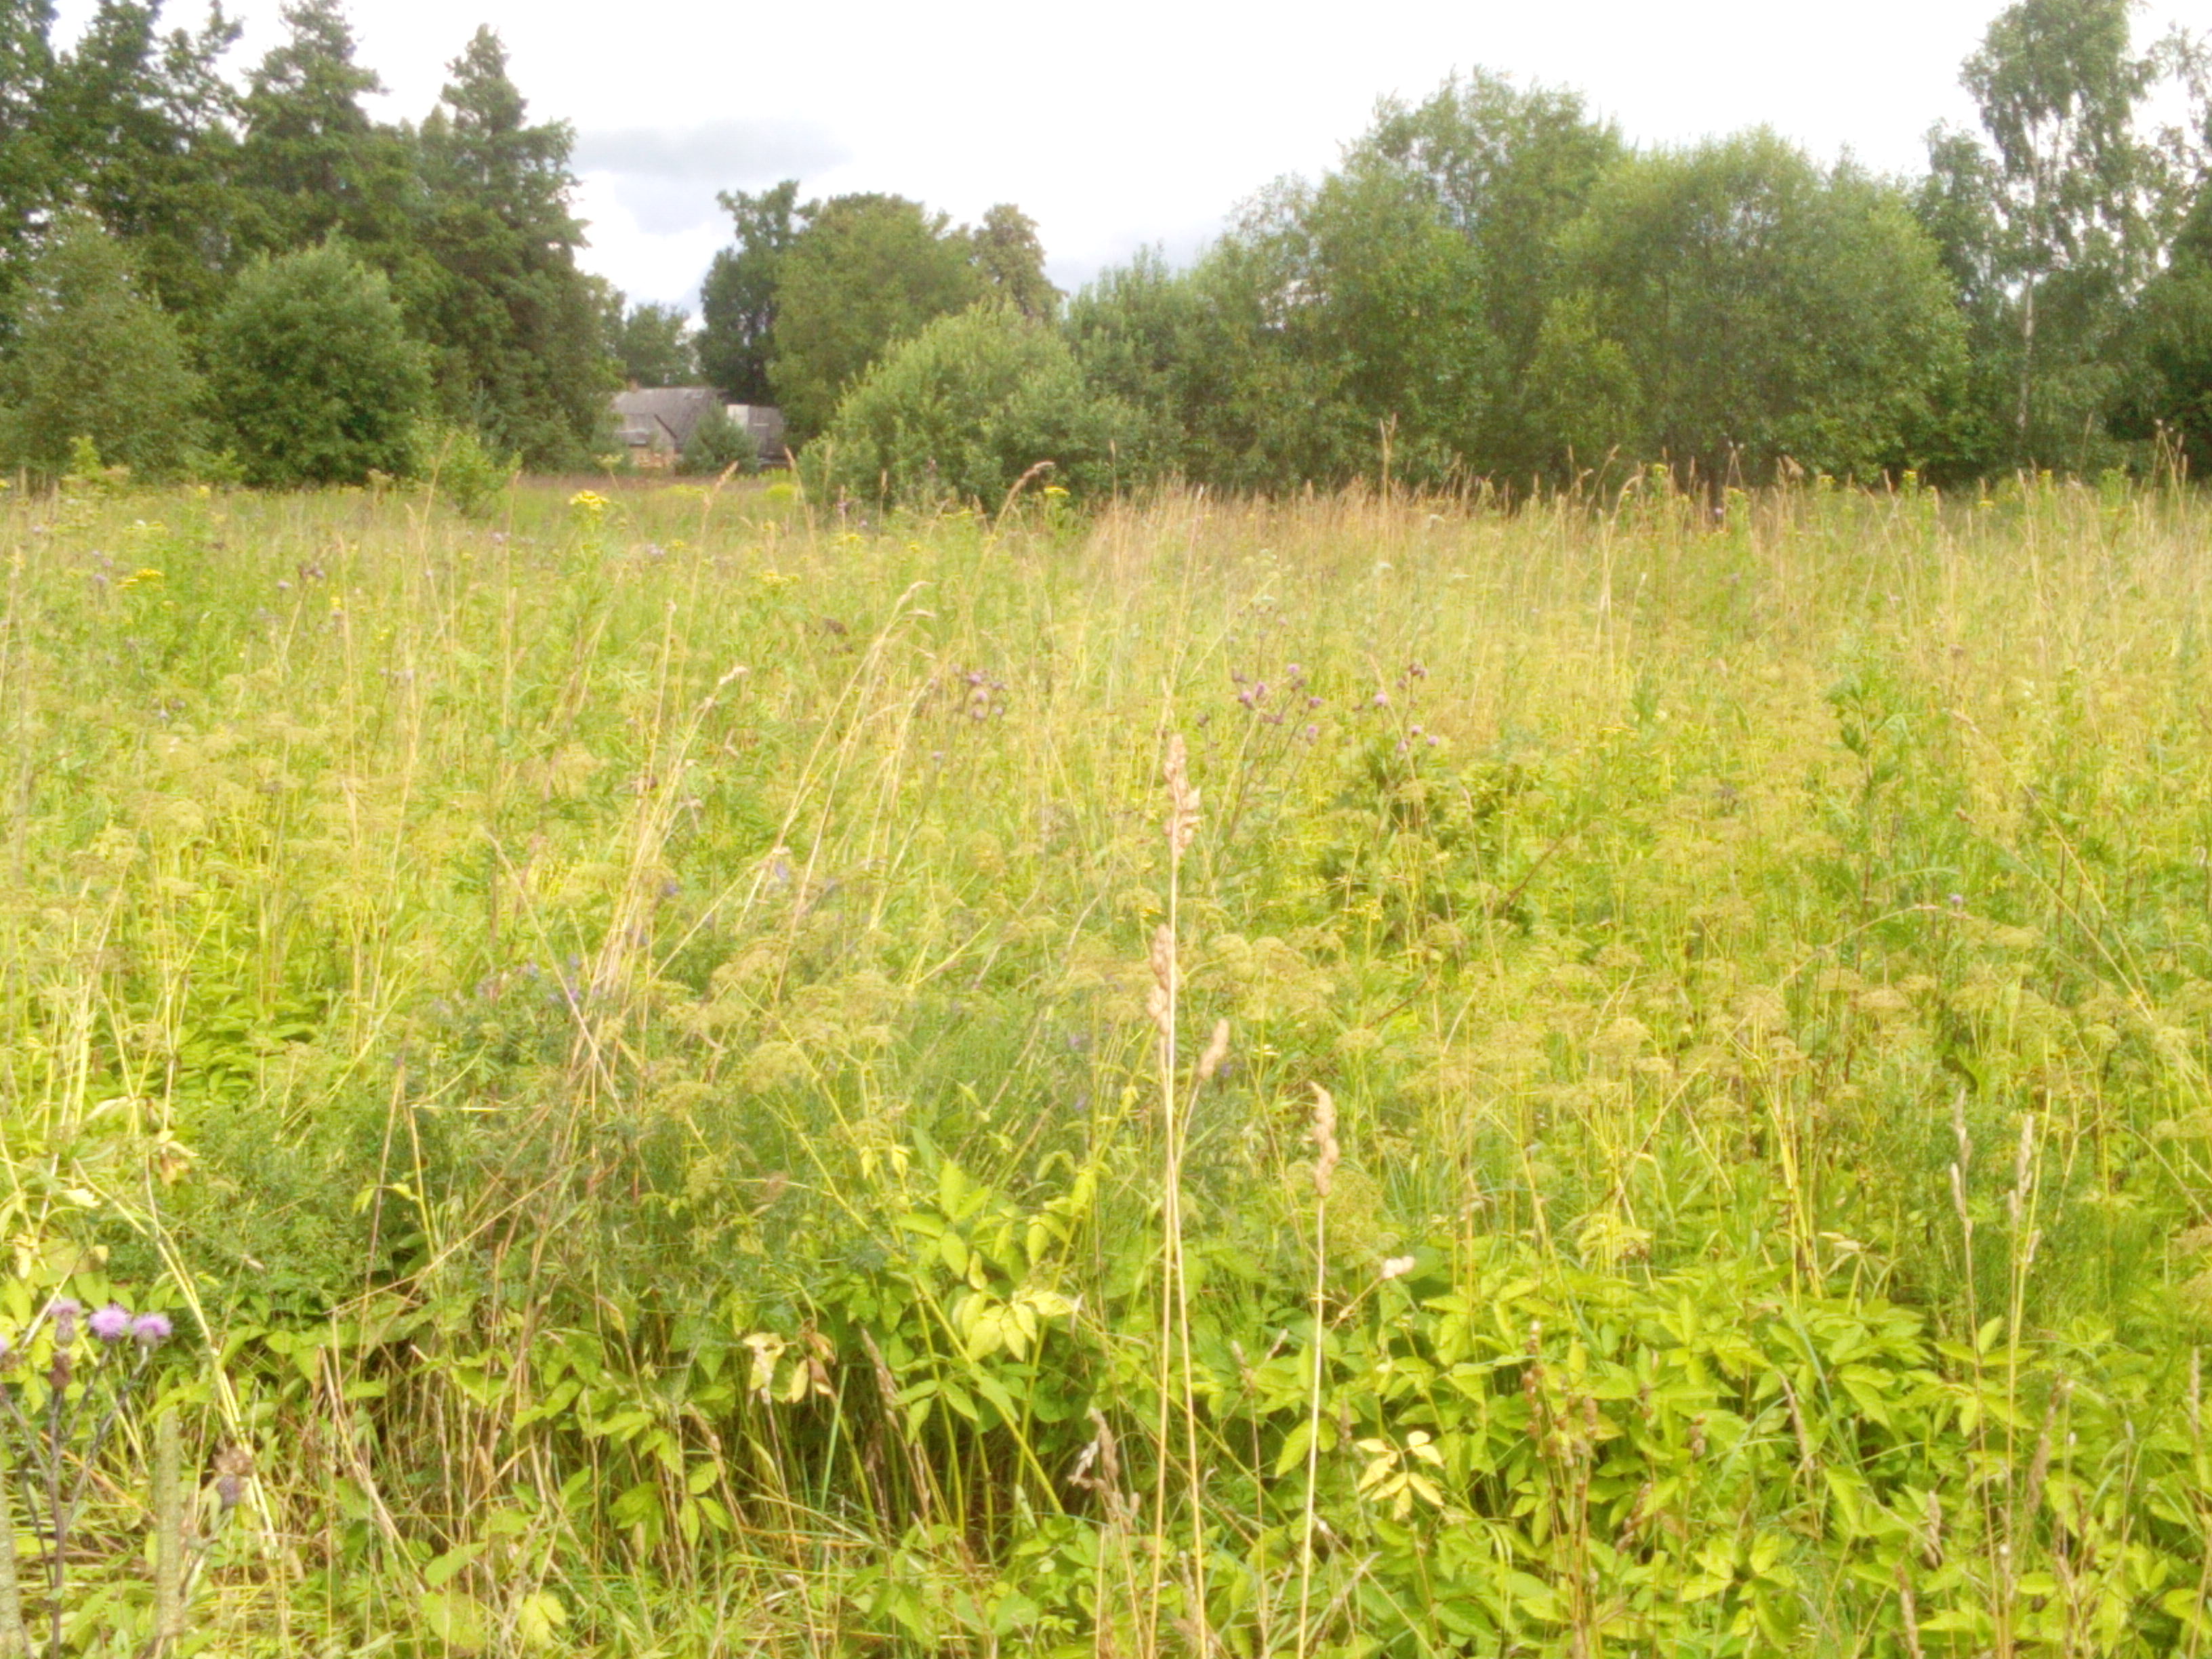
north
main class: Grassland
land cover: Grassland with sparse tree/shrub cover
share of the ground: > 75 %
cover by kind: herbaceous plants 95 %, broadleaved forest trees 5 %
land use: Semi-natural and natural areas not in use
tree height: < 5 m
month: July
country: LV
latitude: 56.9834
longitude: 22.0440
